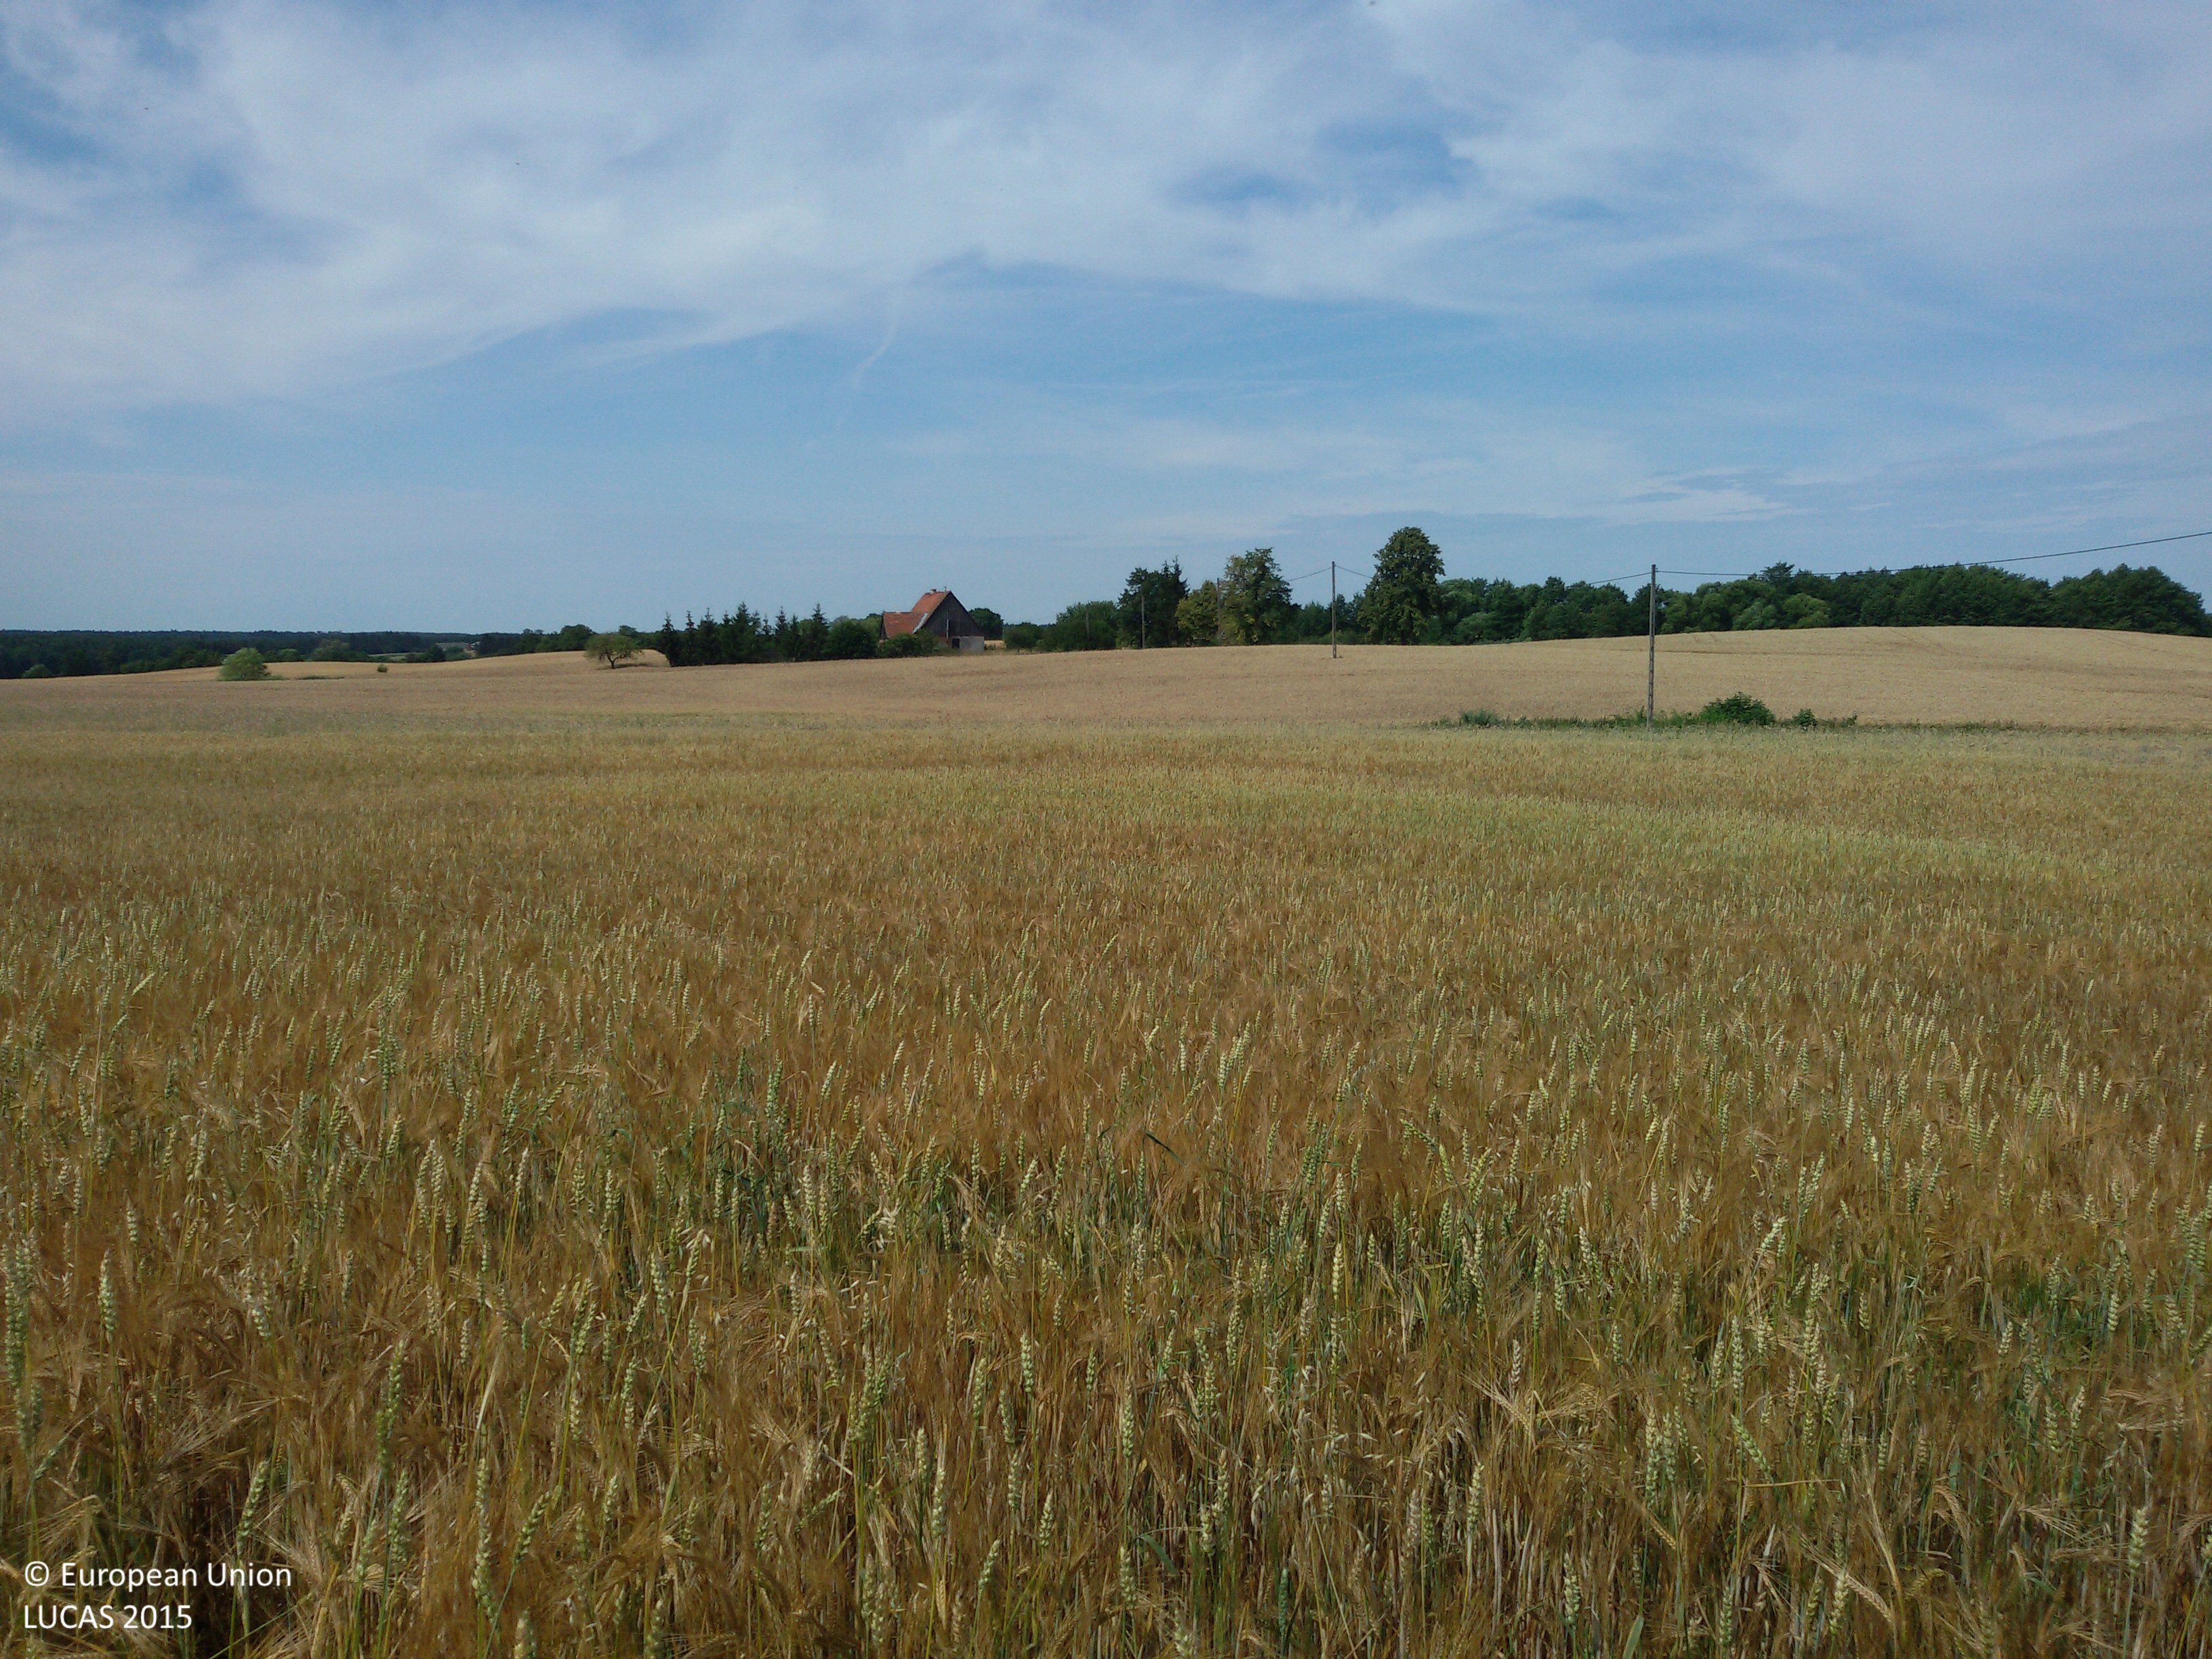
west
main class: Cropland
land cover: Barley
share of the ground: 50 - 75 %
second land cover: Common wheat
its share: 50 - 75 %
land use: Agriculture (excluding fallow land and kitchen gardens)
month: July
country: PL
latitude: 53.4433
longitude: 17.7366
